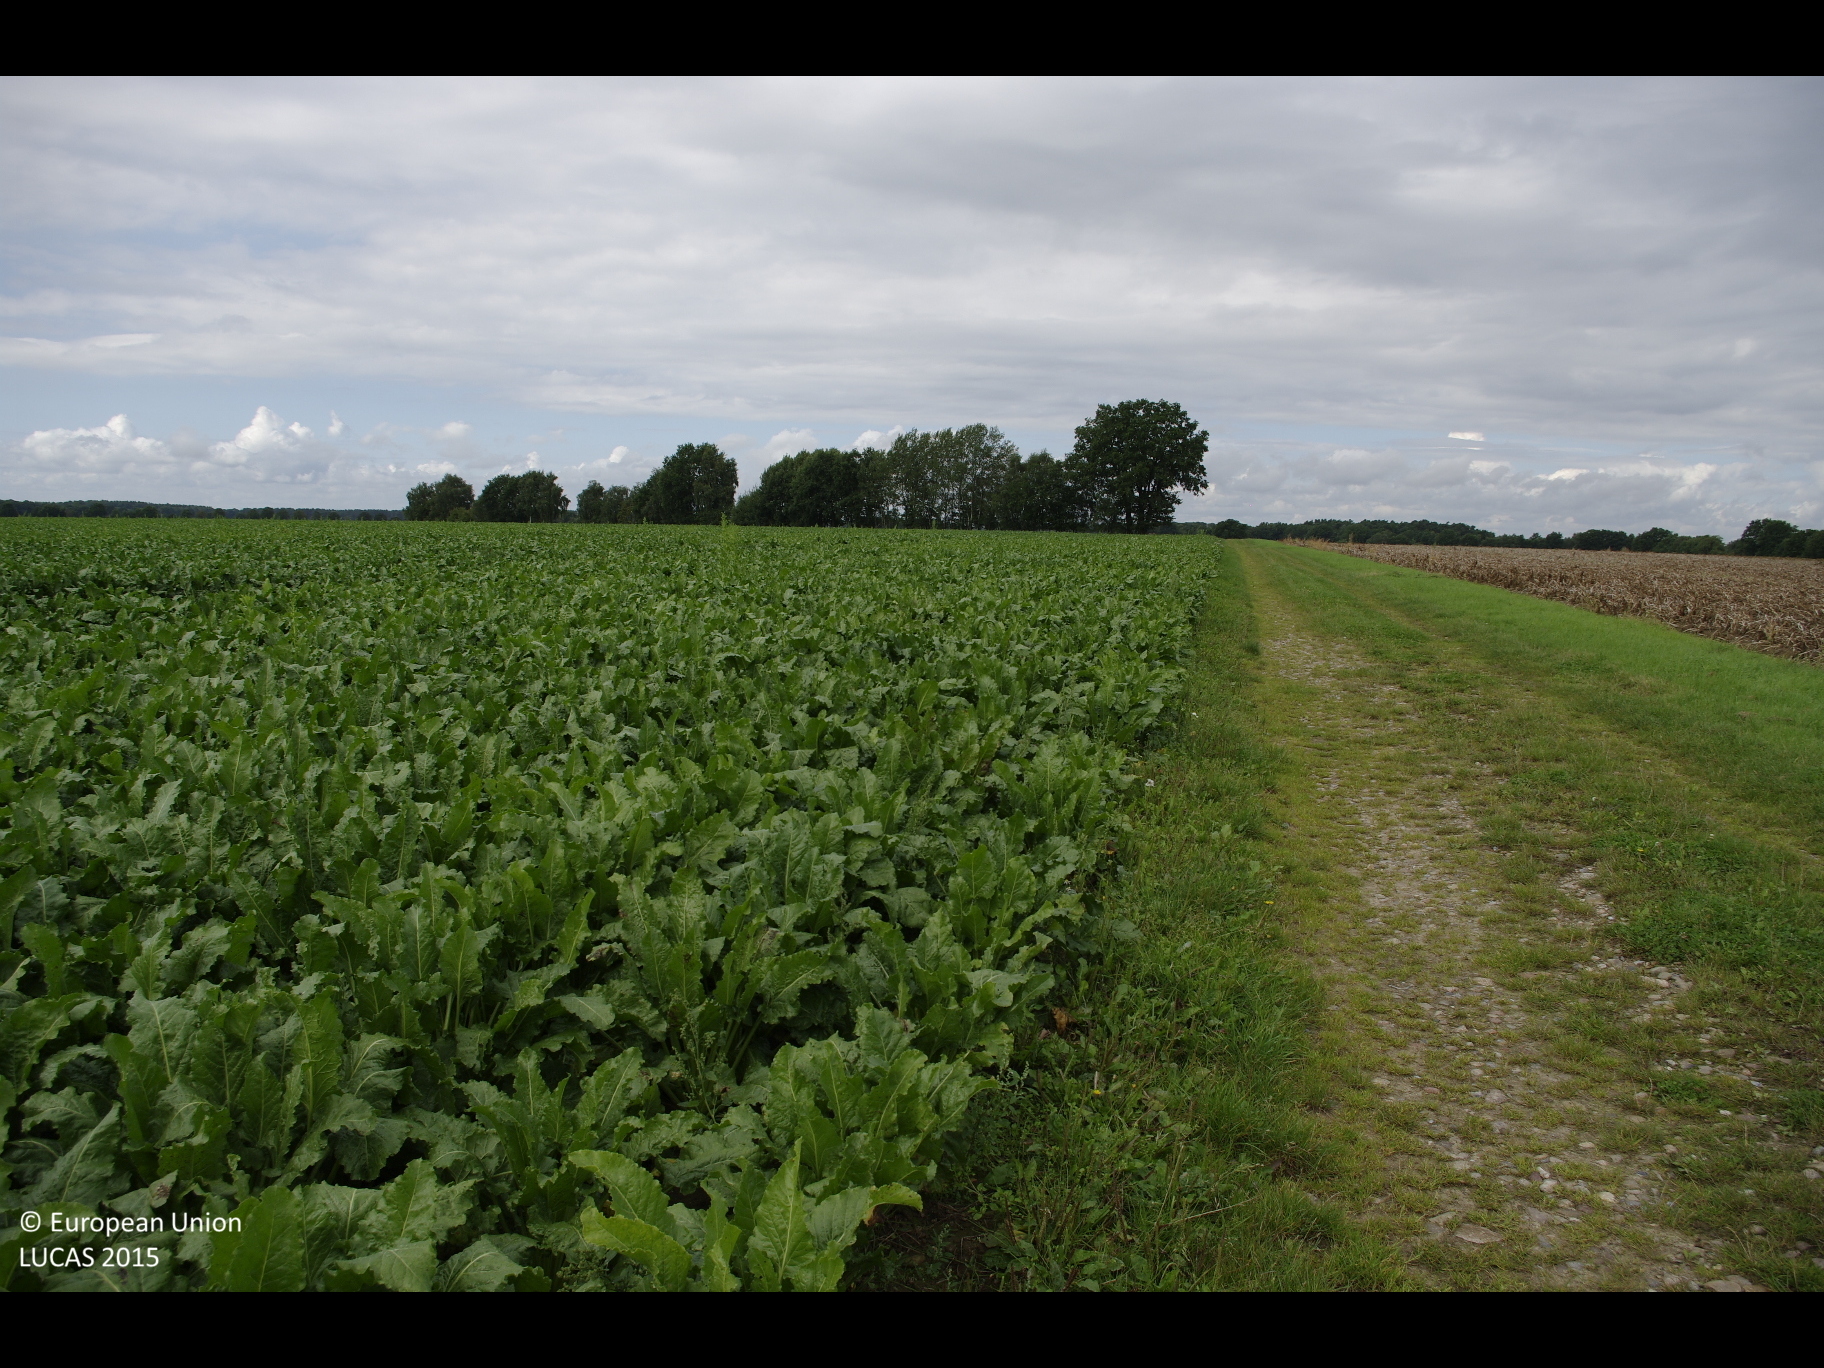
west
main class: Cropland
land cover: Sugar beet
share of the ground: > 75 %
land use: Agriculture (excluding fallow land and kitchen gardens)
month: September
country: DE
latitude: 53.0421
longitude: 10.3131
